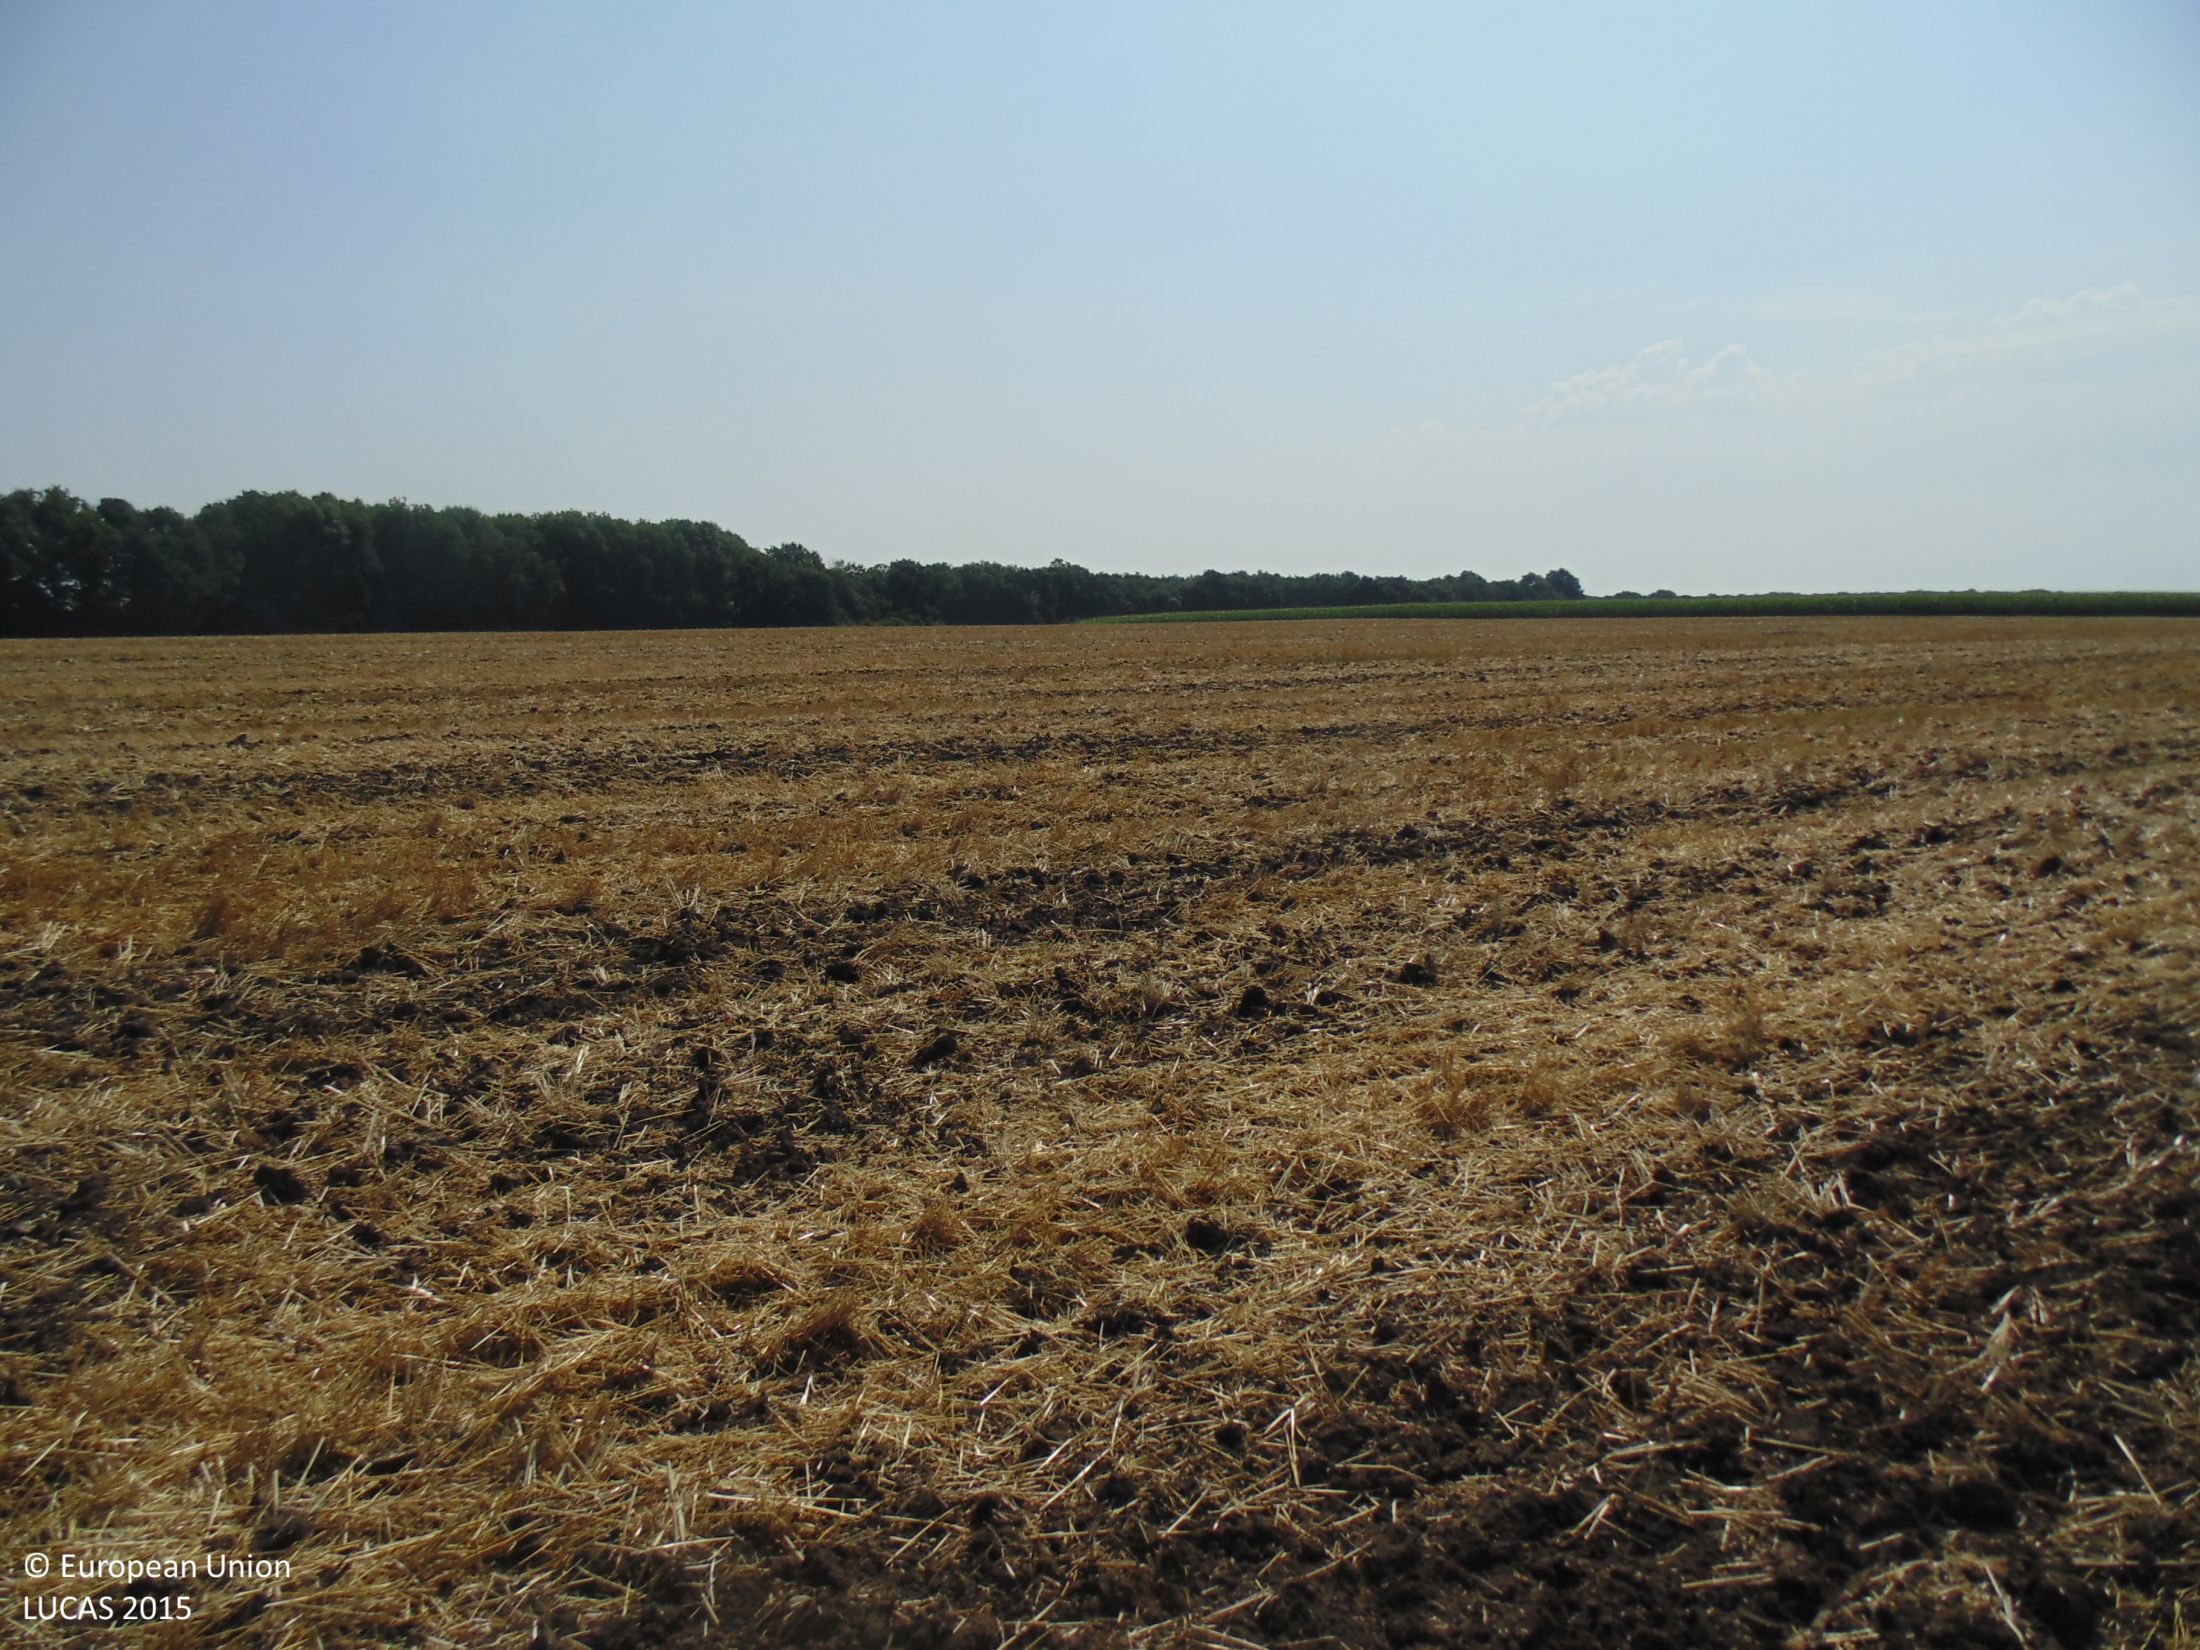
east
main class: Cropland
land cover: Common wheat
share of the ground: 10 - 25 %
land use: Agriculture (excluding fallow land and kitchen gardens)
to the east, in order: Common wheat
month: July
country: BG
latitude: 43.5084
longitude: 27.9433
